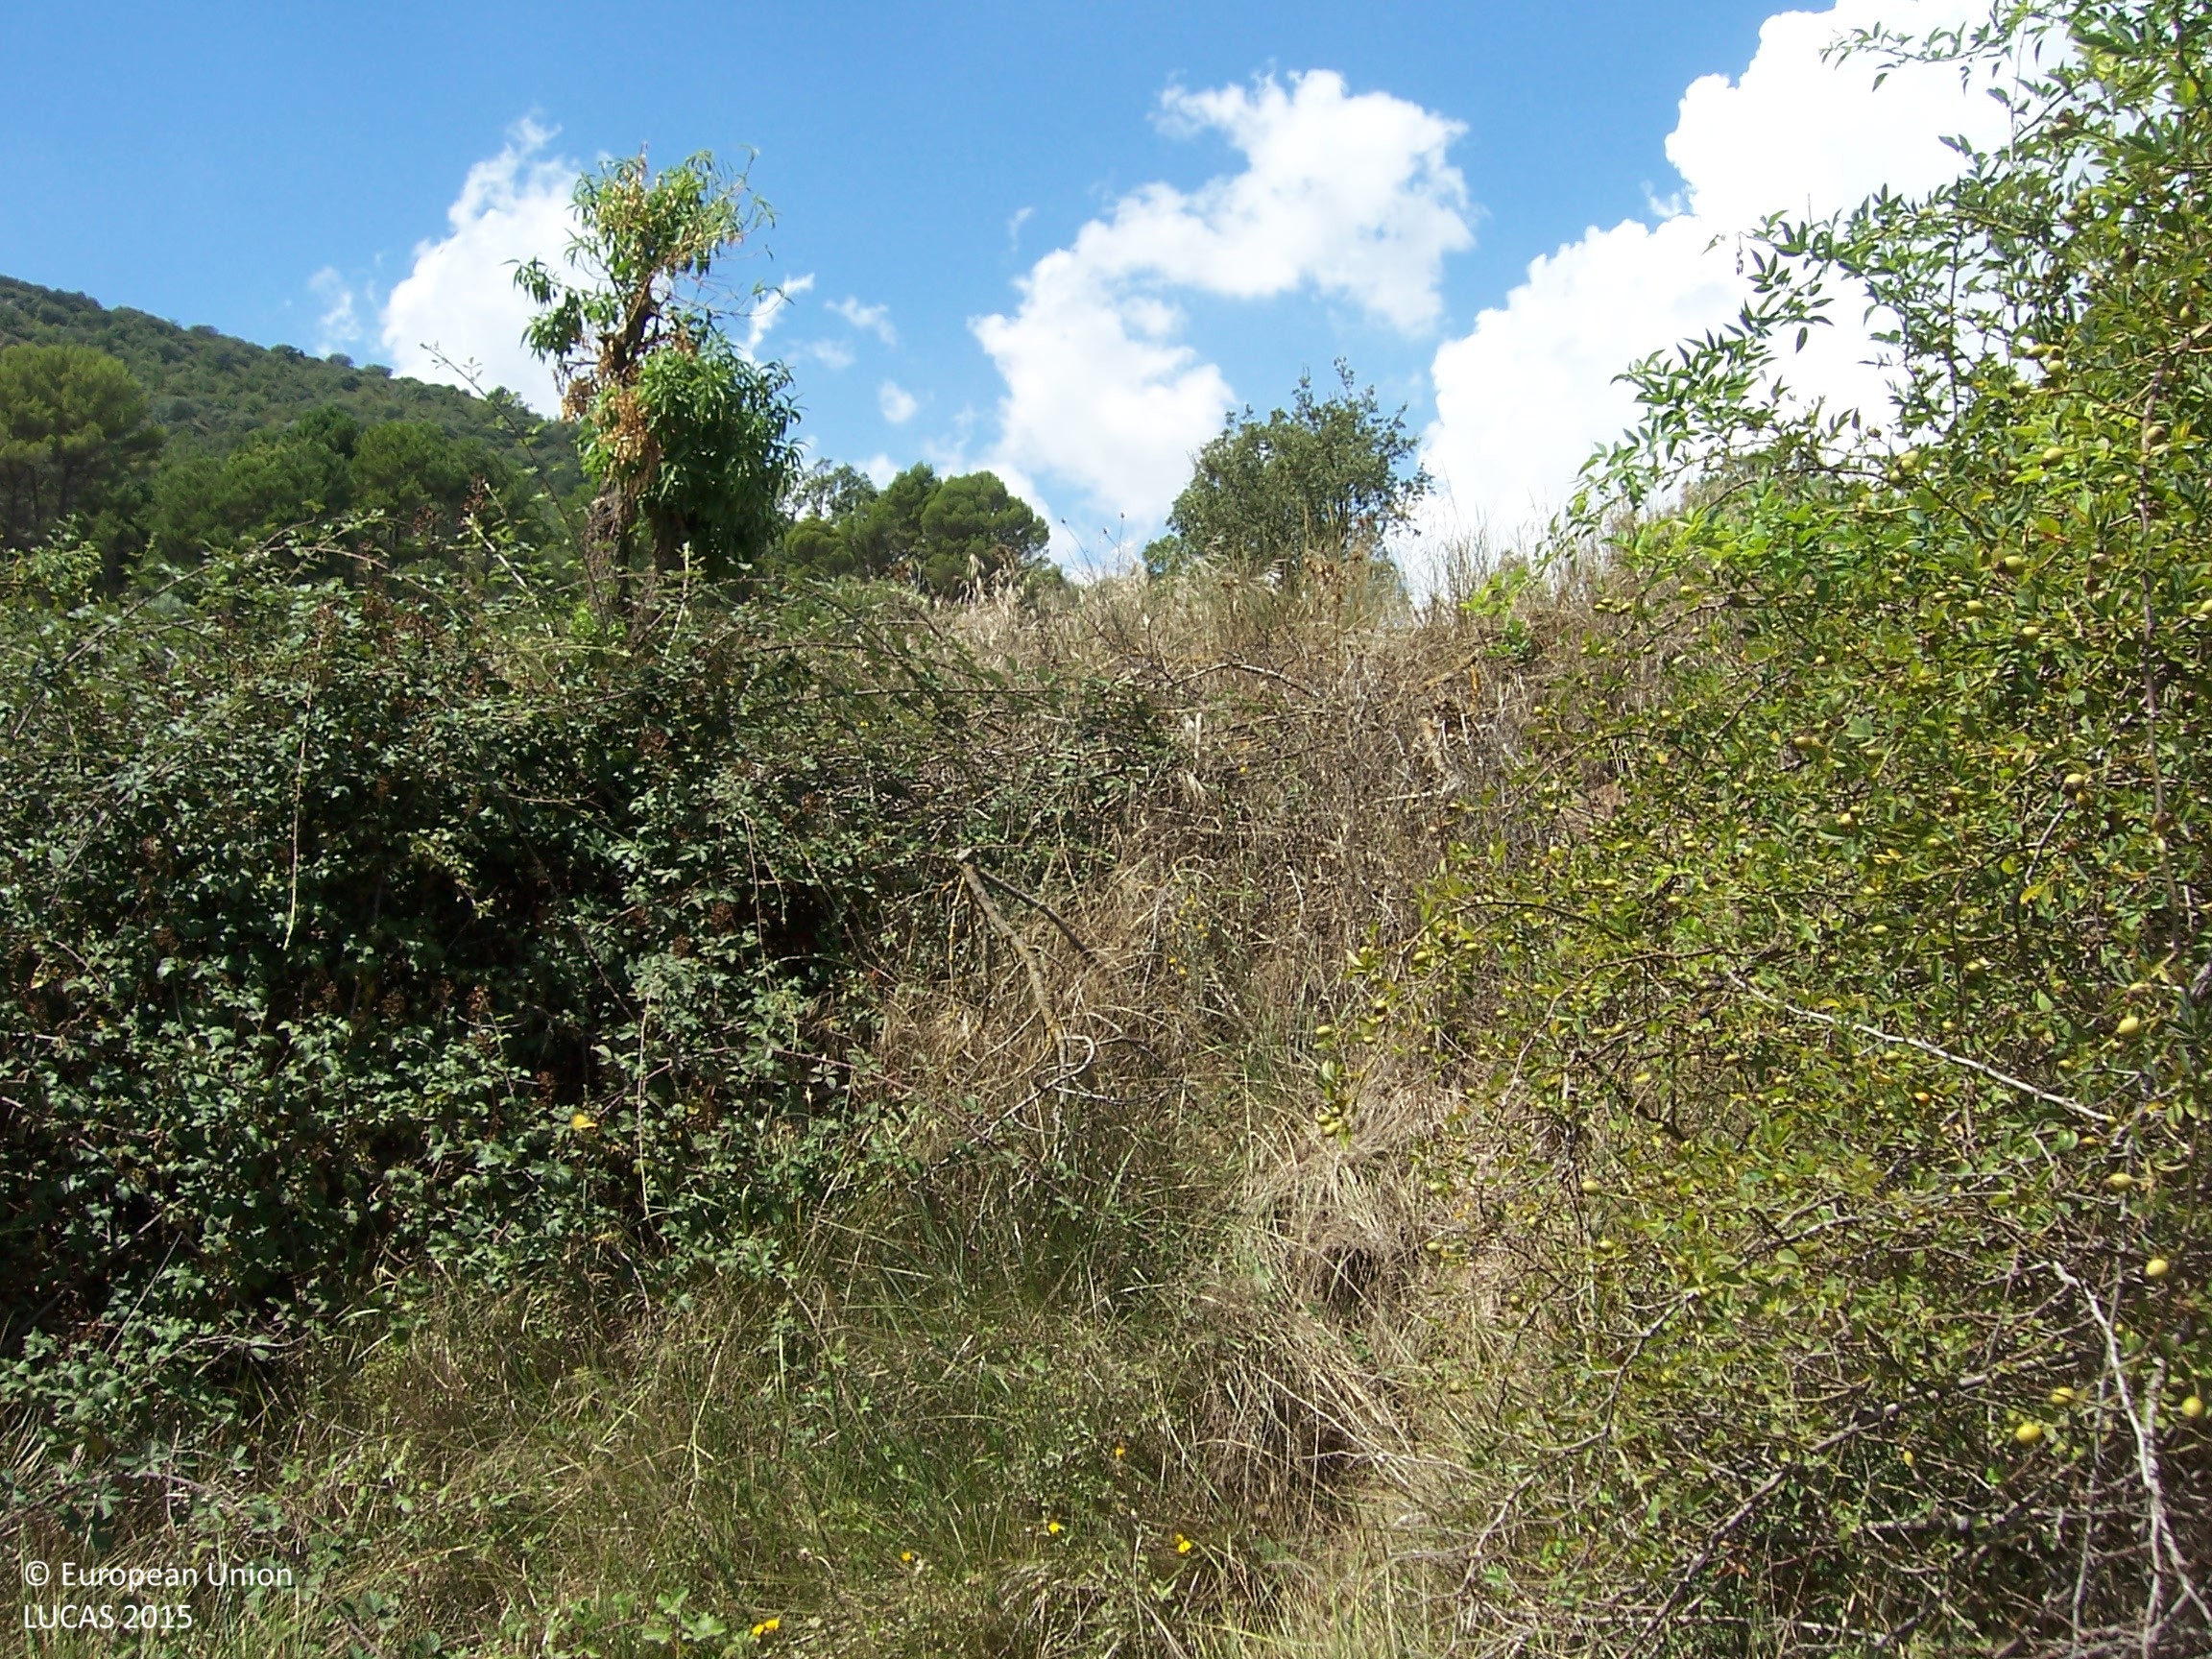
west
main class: Grassland
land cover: Spontaneously vegetated surfaces
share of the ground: > 75 %
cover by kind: herbaceous plants 100 %
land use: Fallow land
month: August
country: ES
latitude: 41.9535
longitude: 0.5143
